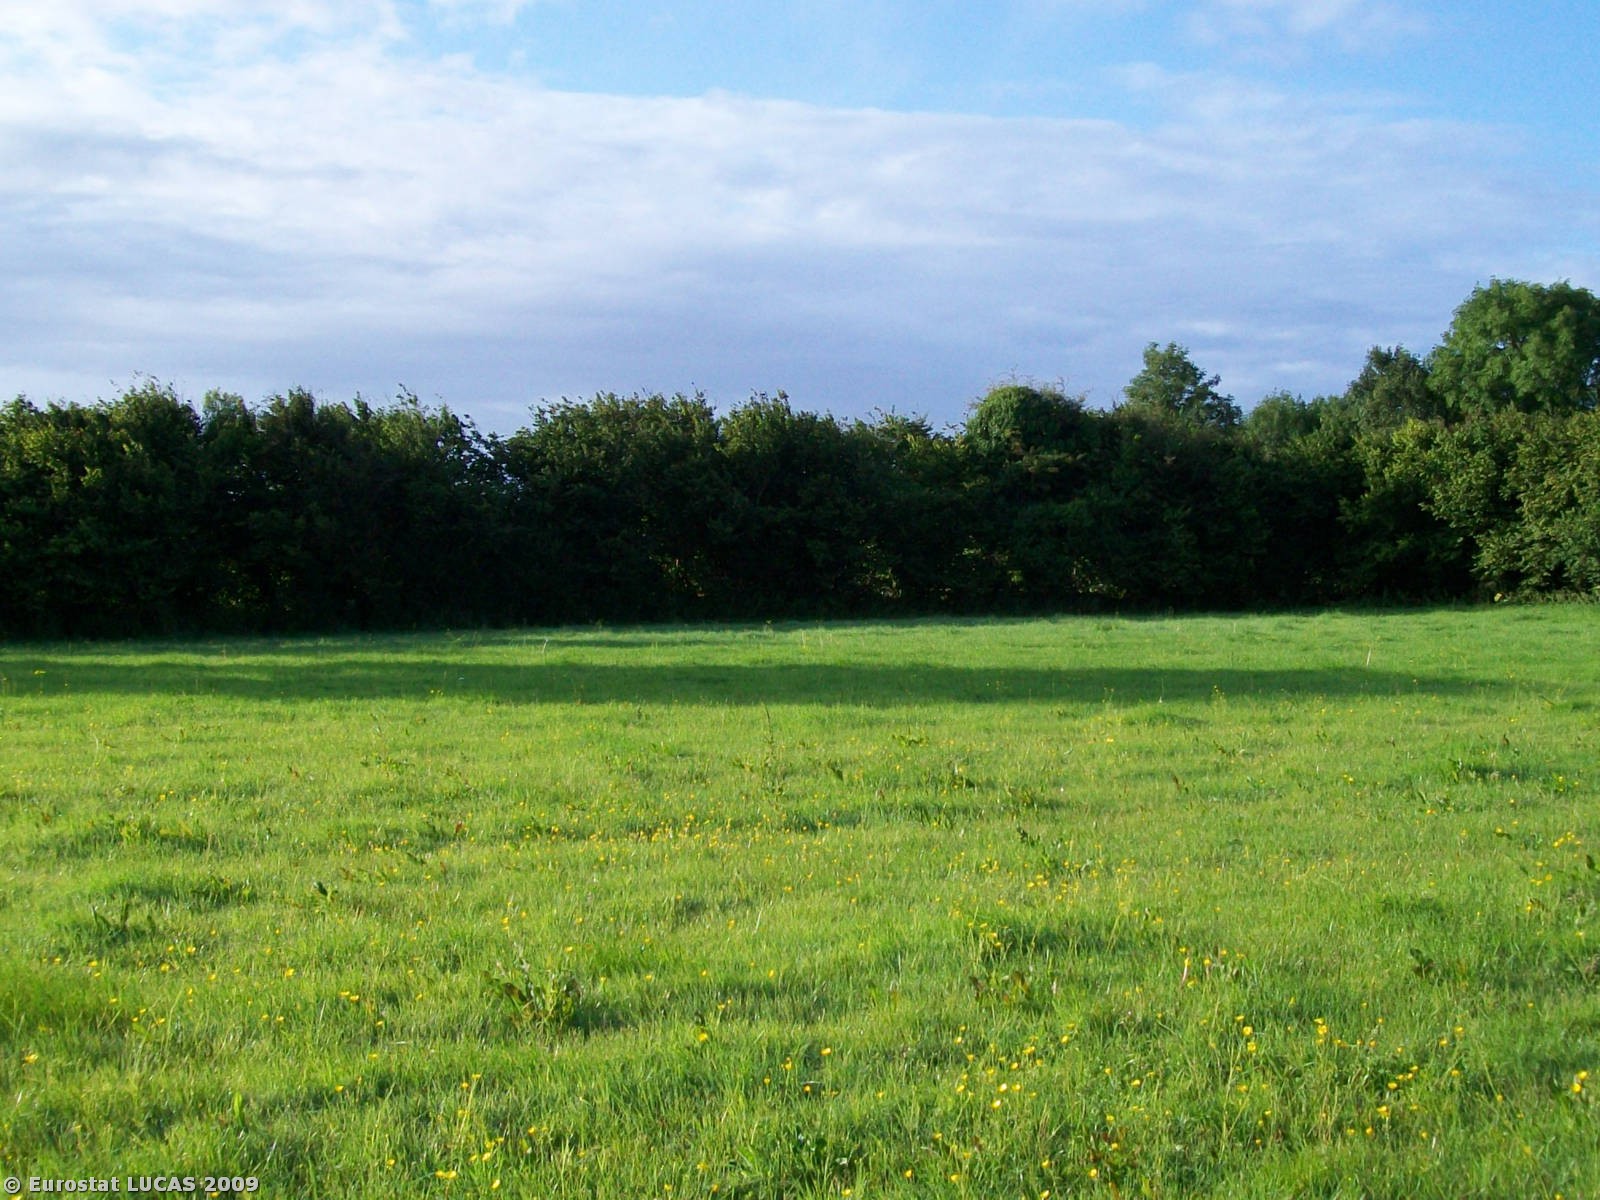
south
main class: Grassland
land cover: Grassland without tree/shrub cover
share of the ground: > 75 %
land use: Agriculture (excluding fallow land and kitchen gardens)
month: August
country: IE
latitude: 53.2283
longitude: -8.7635
